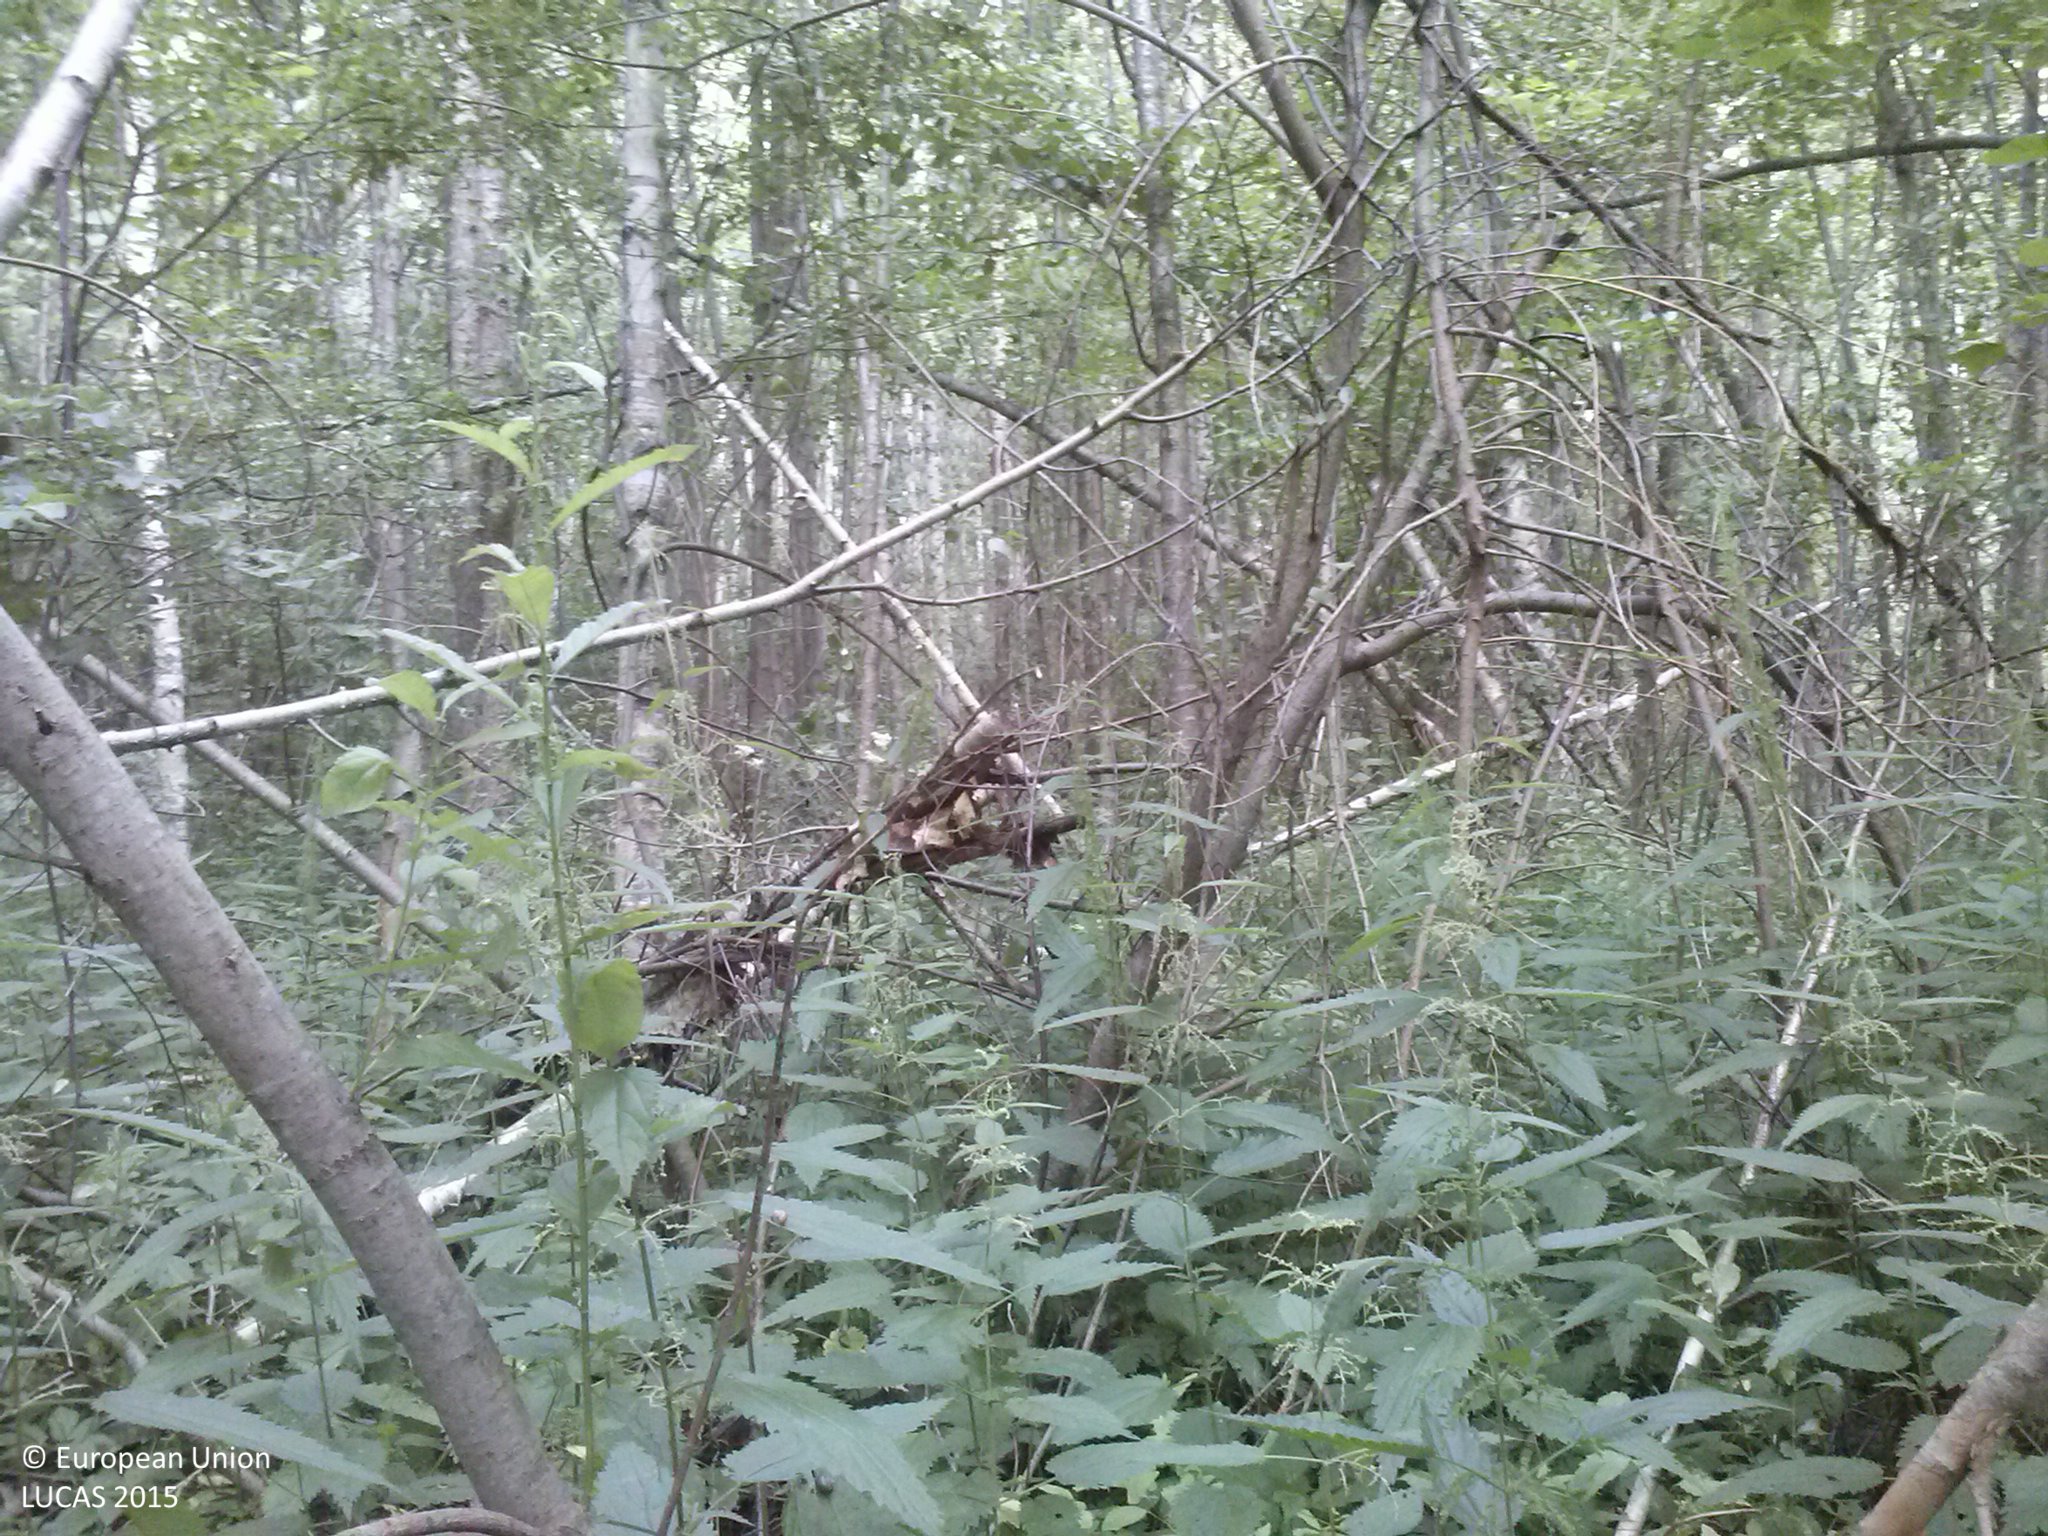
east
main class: Woodland
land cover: Broadleaved woodland
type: non-riverine alder, birch or aspen forest
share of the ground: > 75 %
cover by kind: broadleaved forest trees 75 %, herbaceous plants 15 %, shrubs 10 %
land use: Forestry
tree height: > 5 m
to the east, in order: Broadleaved woodland; Grassland with sparse tree/shrub cover; Spontaneously vegetated surfaces; Ditches and canals; Spontaneously vegetated surfaces
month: July
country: LV
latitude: 56.5562
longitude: 26.9681
